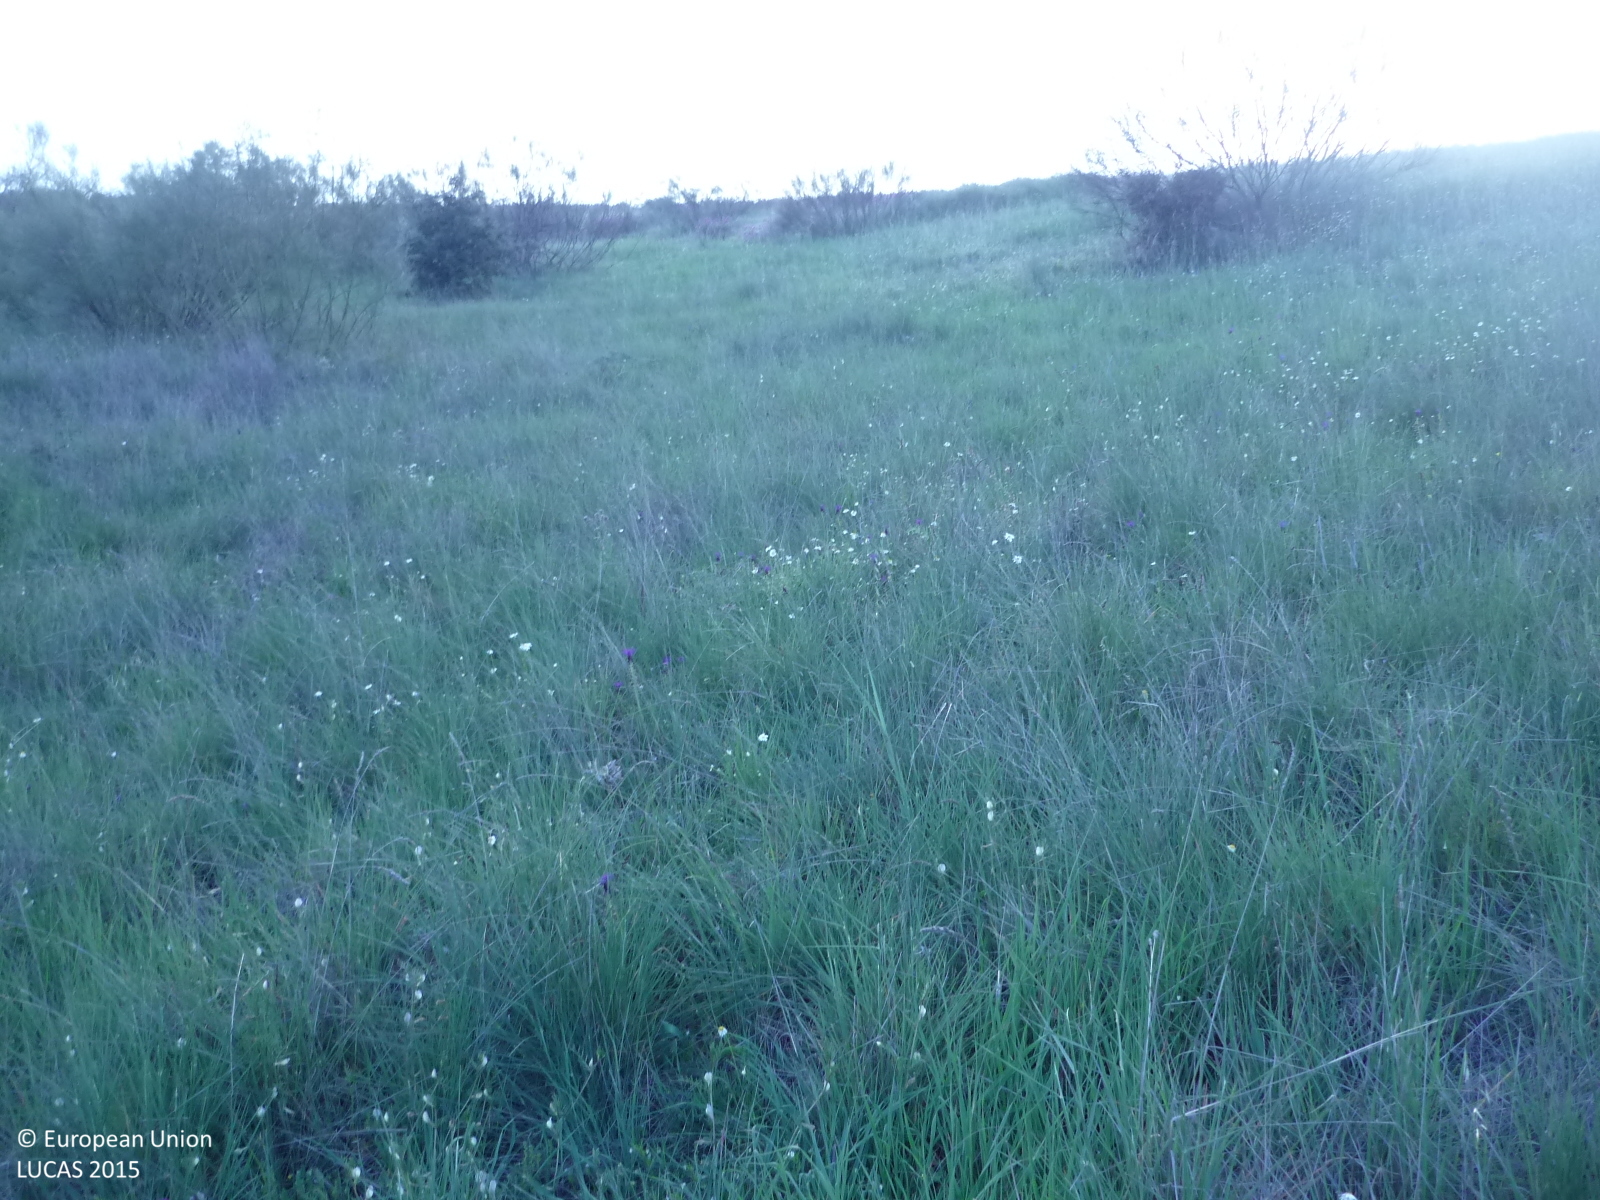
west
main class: Grassland
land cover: Grassland with sparse tree/shrub cover
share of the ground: > 75 %
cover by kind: herbaceous plants 85 %, shrubs 10 %, broadleaved forest trees 5 %
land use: Agriculture (excluding fallow land and kitchen gardens)
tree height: < 5 m
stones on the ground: < 10 %
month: April
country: ES
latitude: 40.7083
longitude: -3.5925
